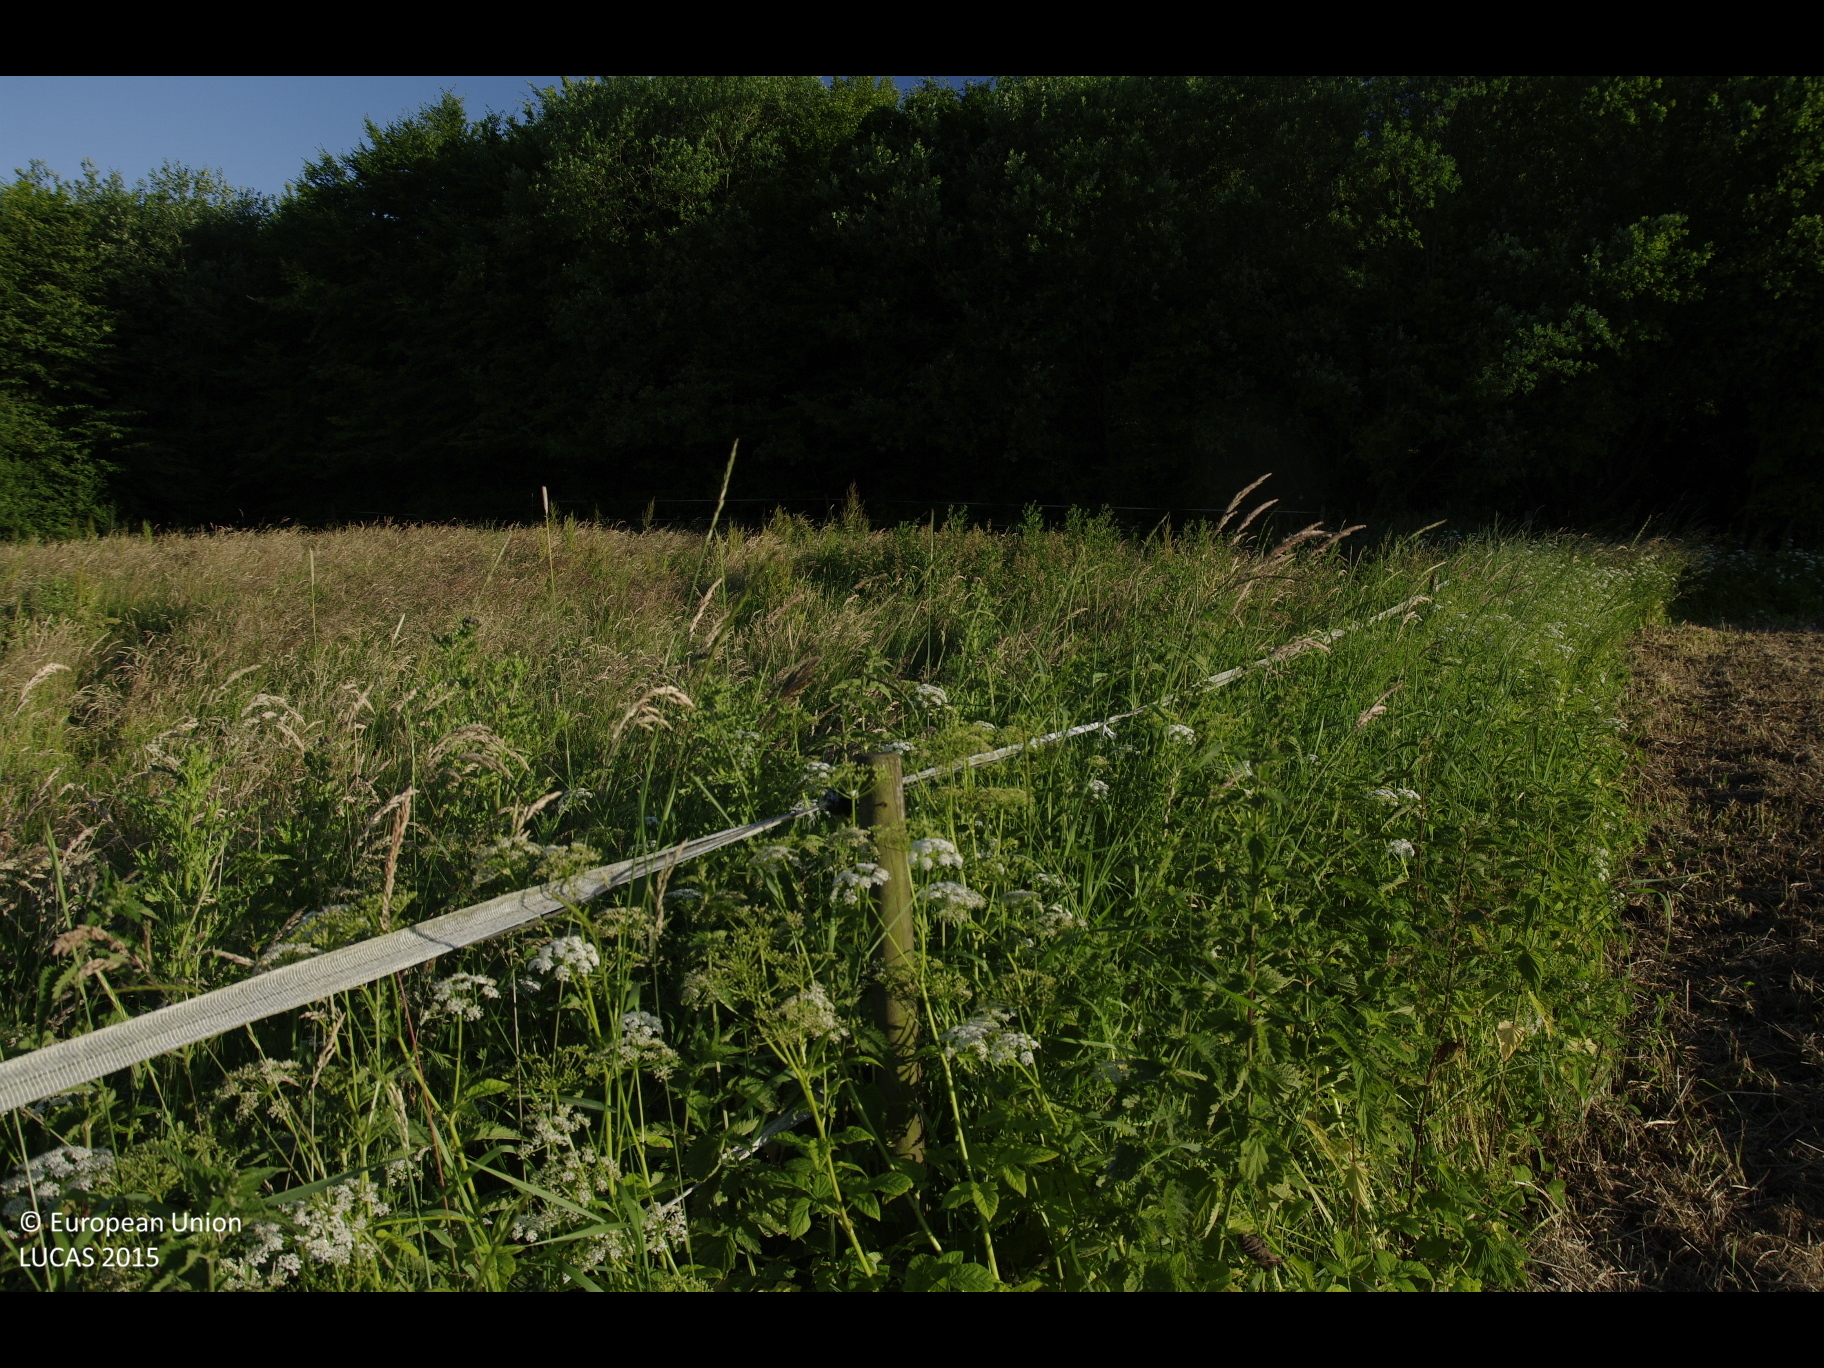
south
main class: Grassland
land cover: Grassland without tree/shrub cover
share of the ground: > 75 %
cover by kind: herbaceous plants 100 %
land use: Agriculture (excluding fallow land and kitchen gardens)
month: June
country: DE
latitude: 53.7059
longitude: 10.6208
